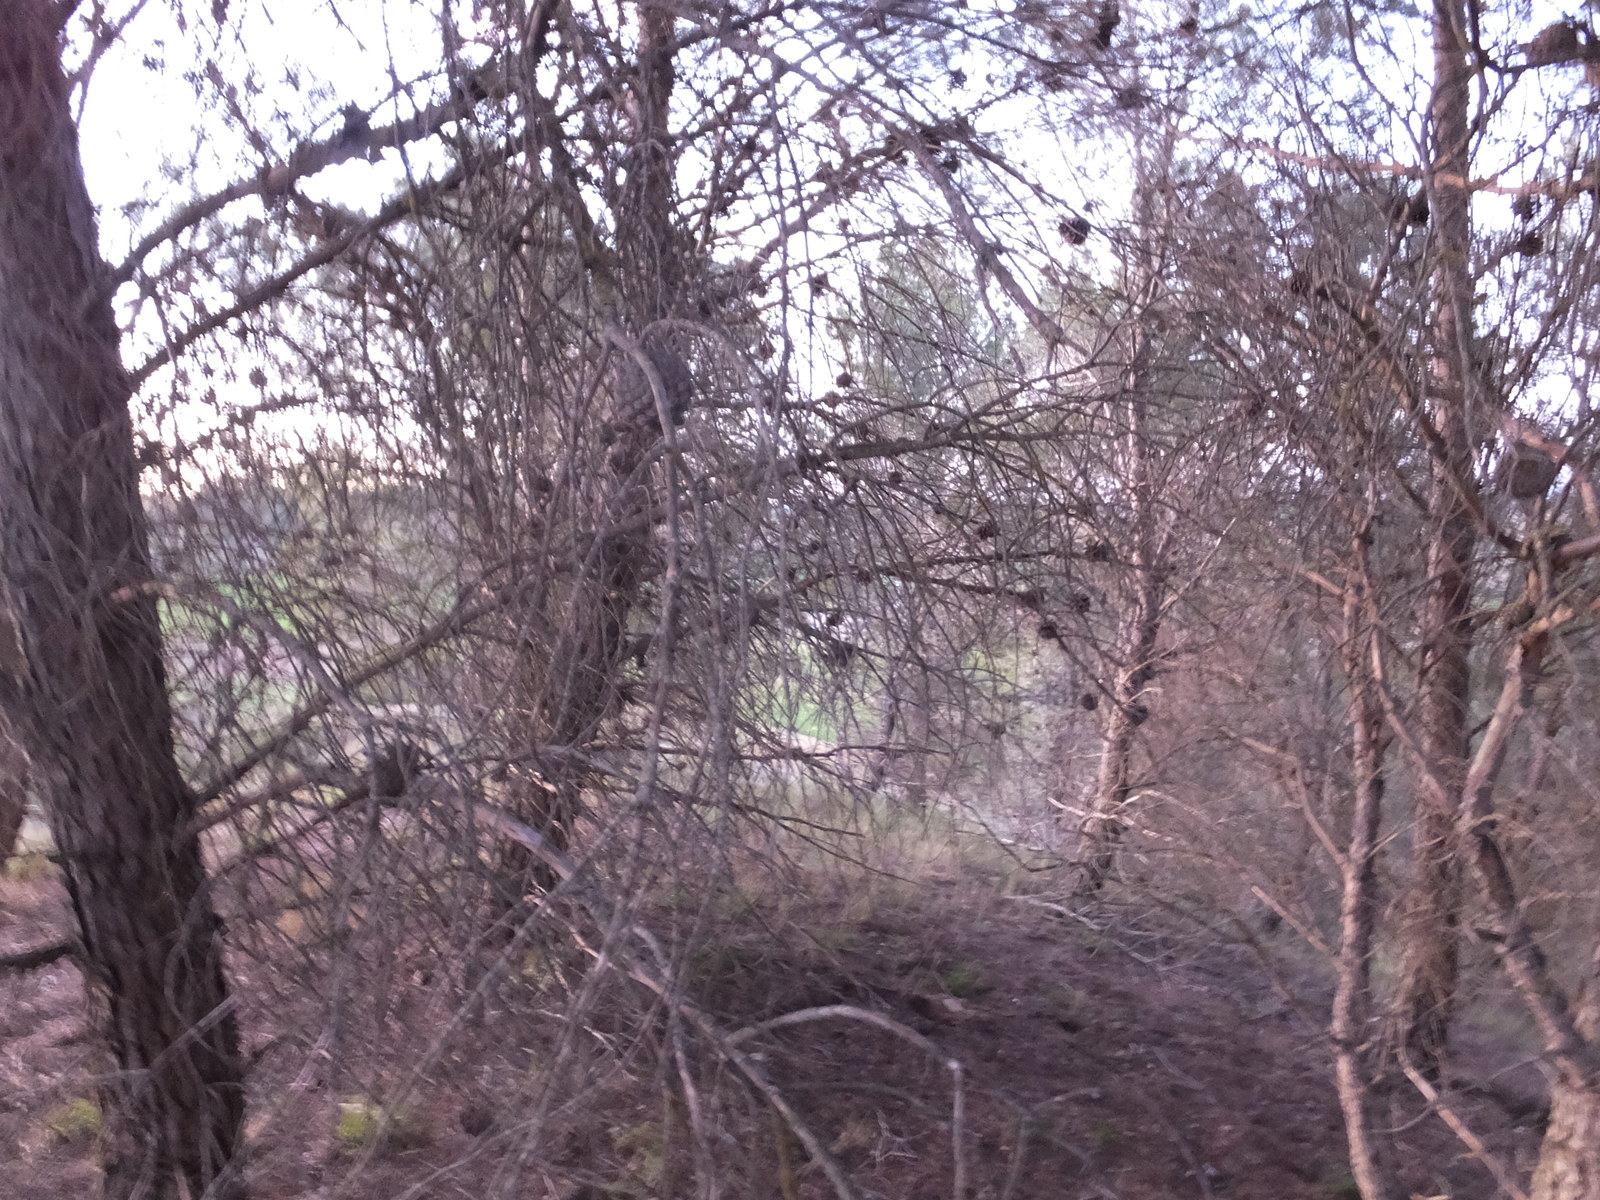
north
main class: Woodland
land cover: Pine dominated coniferous woodland
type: coniferous forest of the mediterranean region
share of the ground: 50 - 75 %
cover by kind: coniferous forest trees 75 %, herbaceous plants 25 %
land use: Forestry
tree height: > 5 m
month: April
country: ES
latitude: 41.7528
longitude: -0.2285
